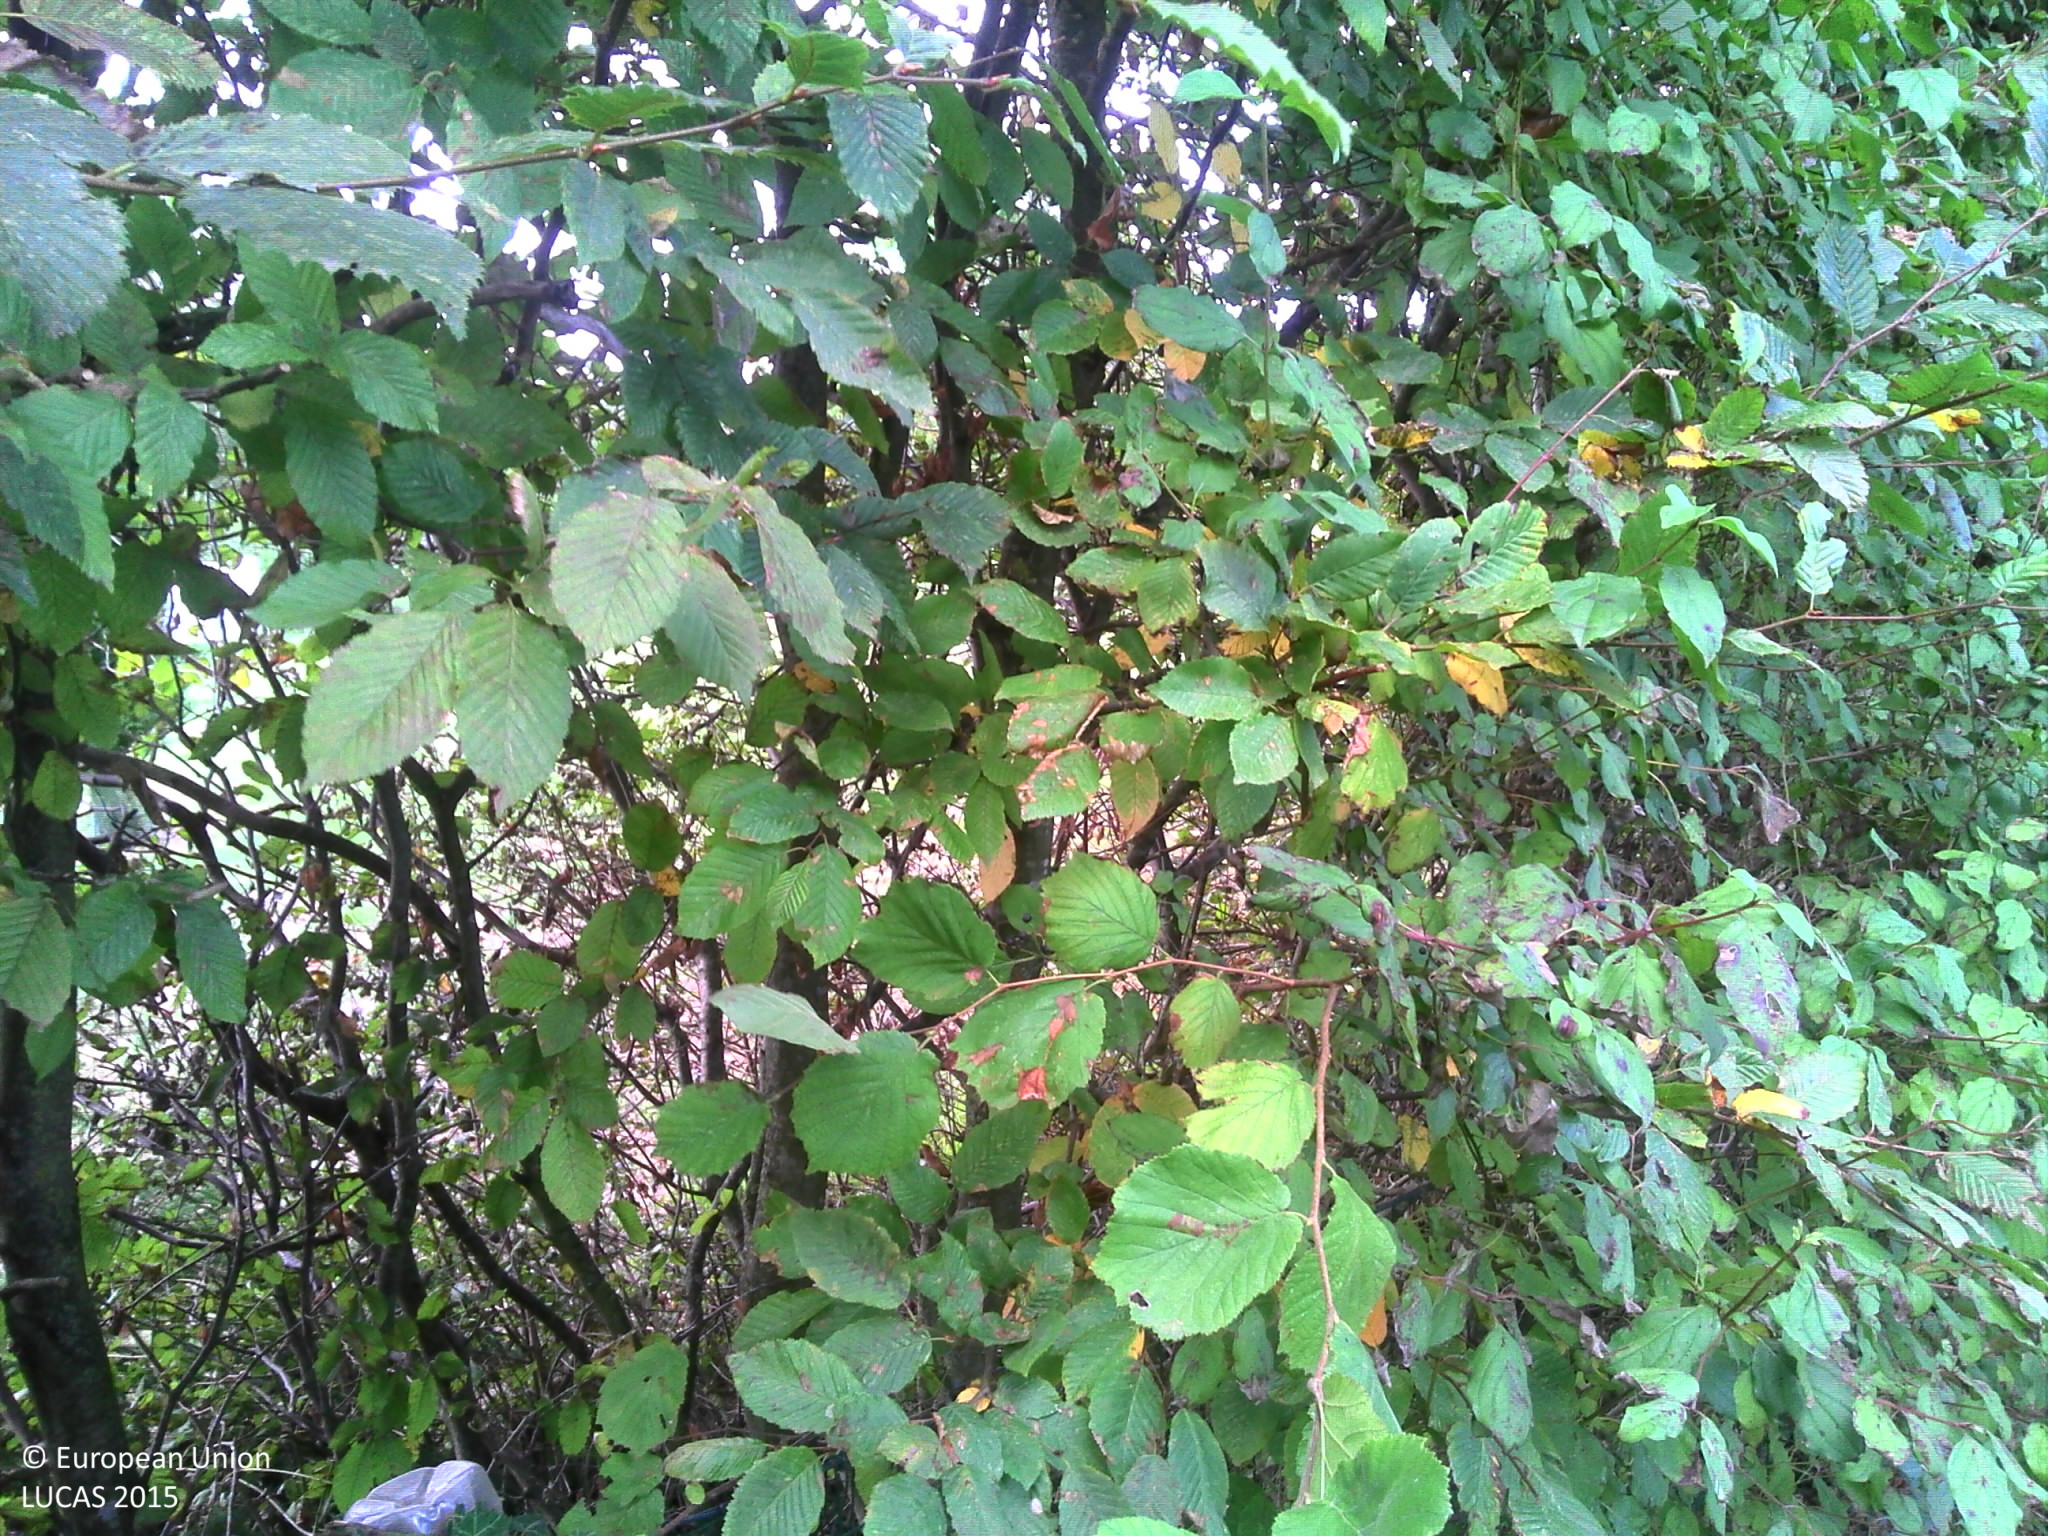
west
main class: Grassland
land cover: Grassland with sparse tree/shrub cover
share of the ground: > 75 %
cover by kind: herbaceous plants 95 %, coniferous forest trees 5 %
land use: Residential
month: September
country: FR
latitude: 46.9843
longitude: 1.4286
